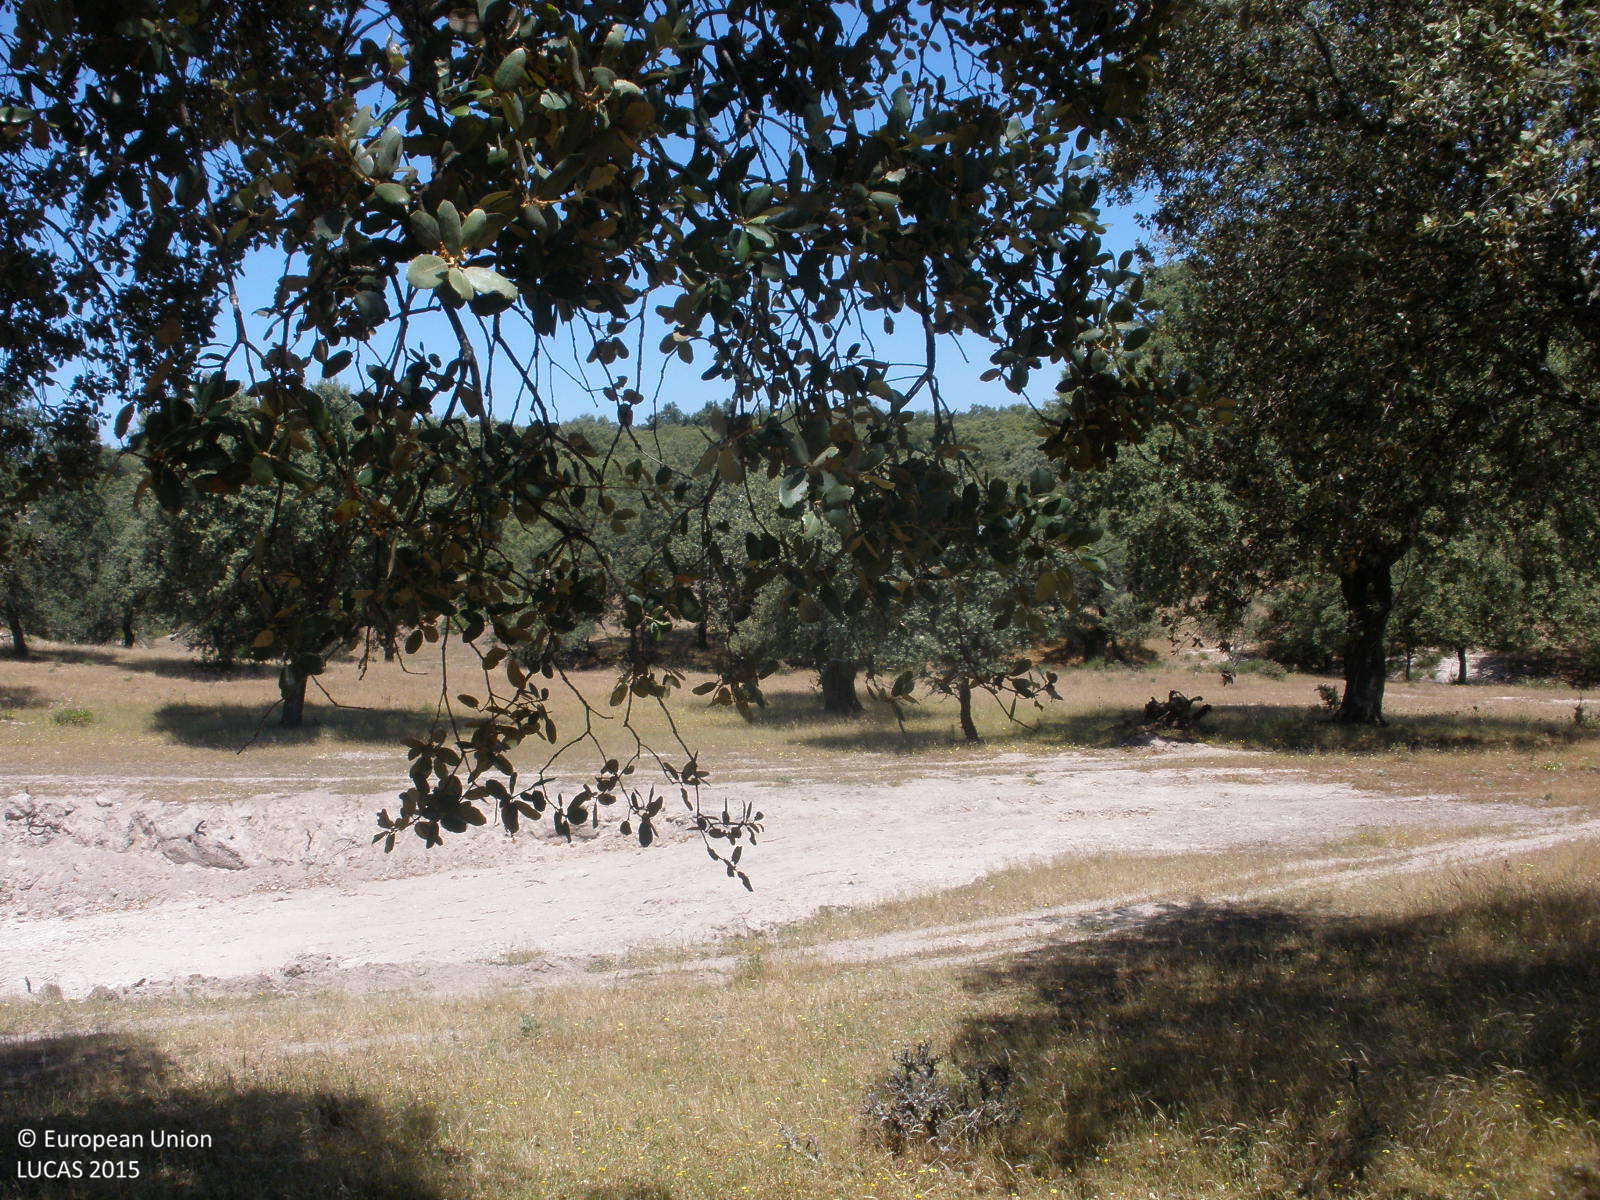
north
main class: Woodland
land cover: Broadleaved woodland
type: broadleaved evergreen forest
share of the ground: > 75 %
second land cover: Grassland without tree/shrub cover
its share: > 75 %
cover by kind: broadleaved forest trees 70 %, herbaceous plants 30 %
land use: Forestry
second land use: Agriculture (excluding fallow land and kitchen gardens)
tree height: > 5 m
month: May
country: ES
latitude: 40.2038
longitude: -6.0631
